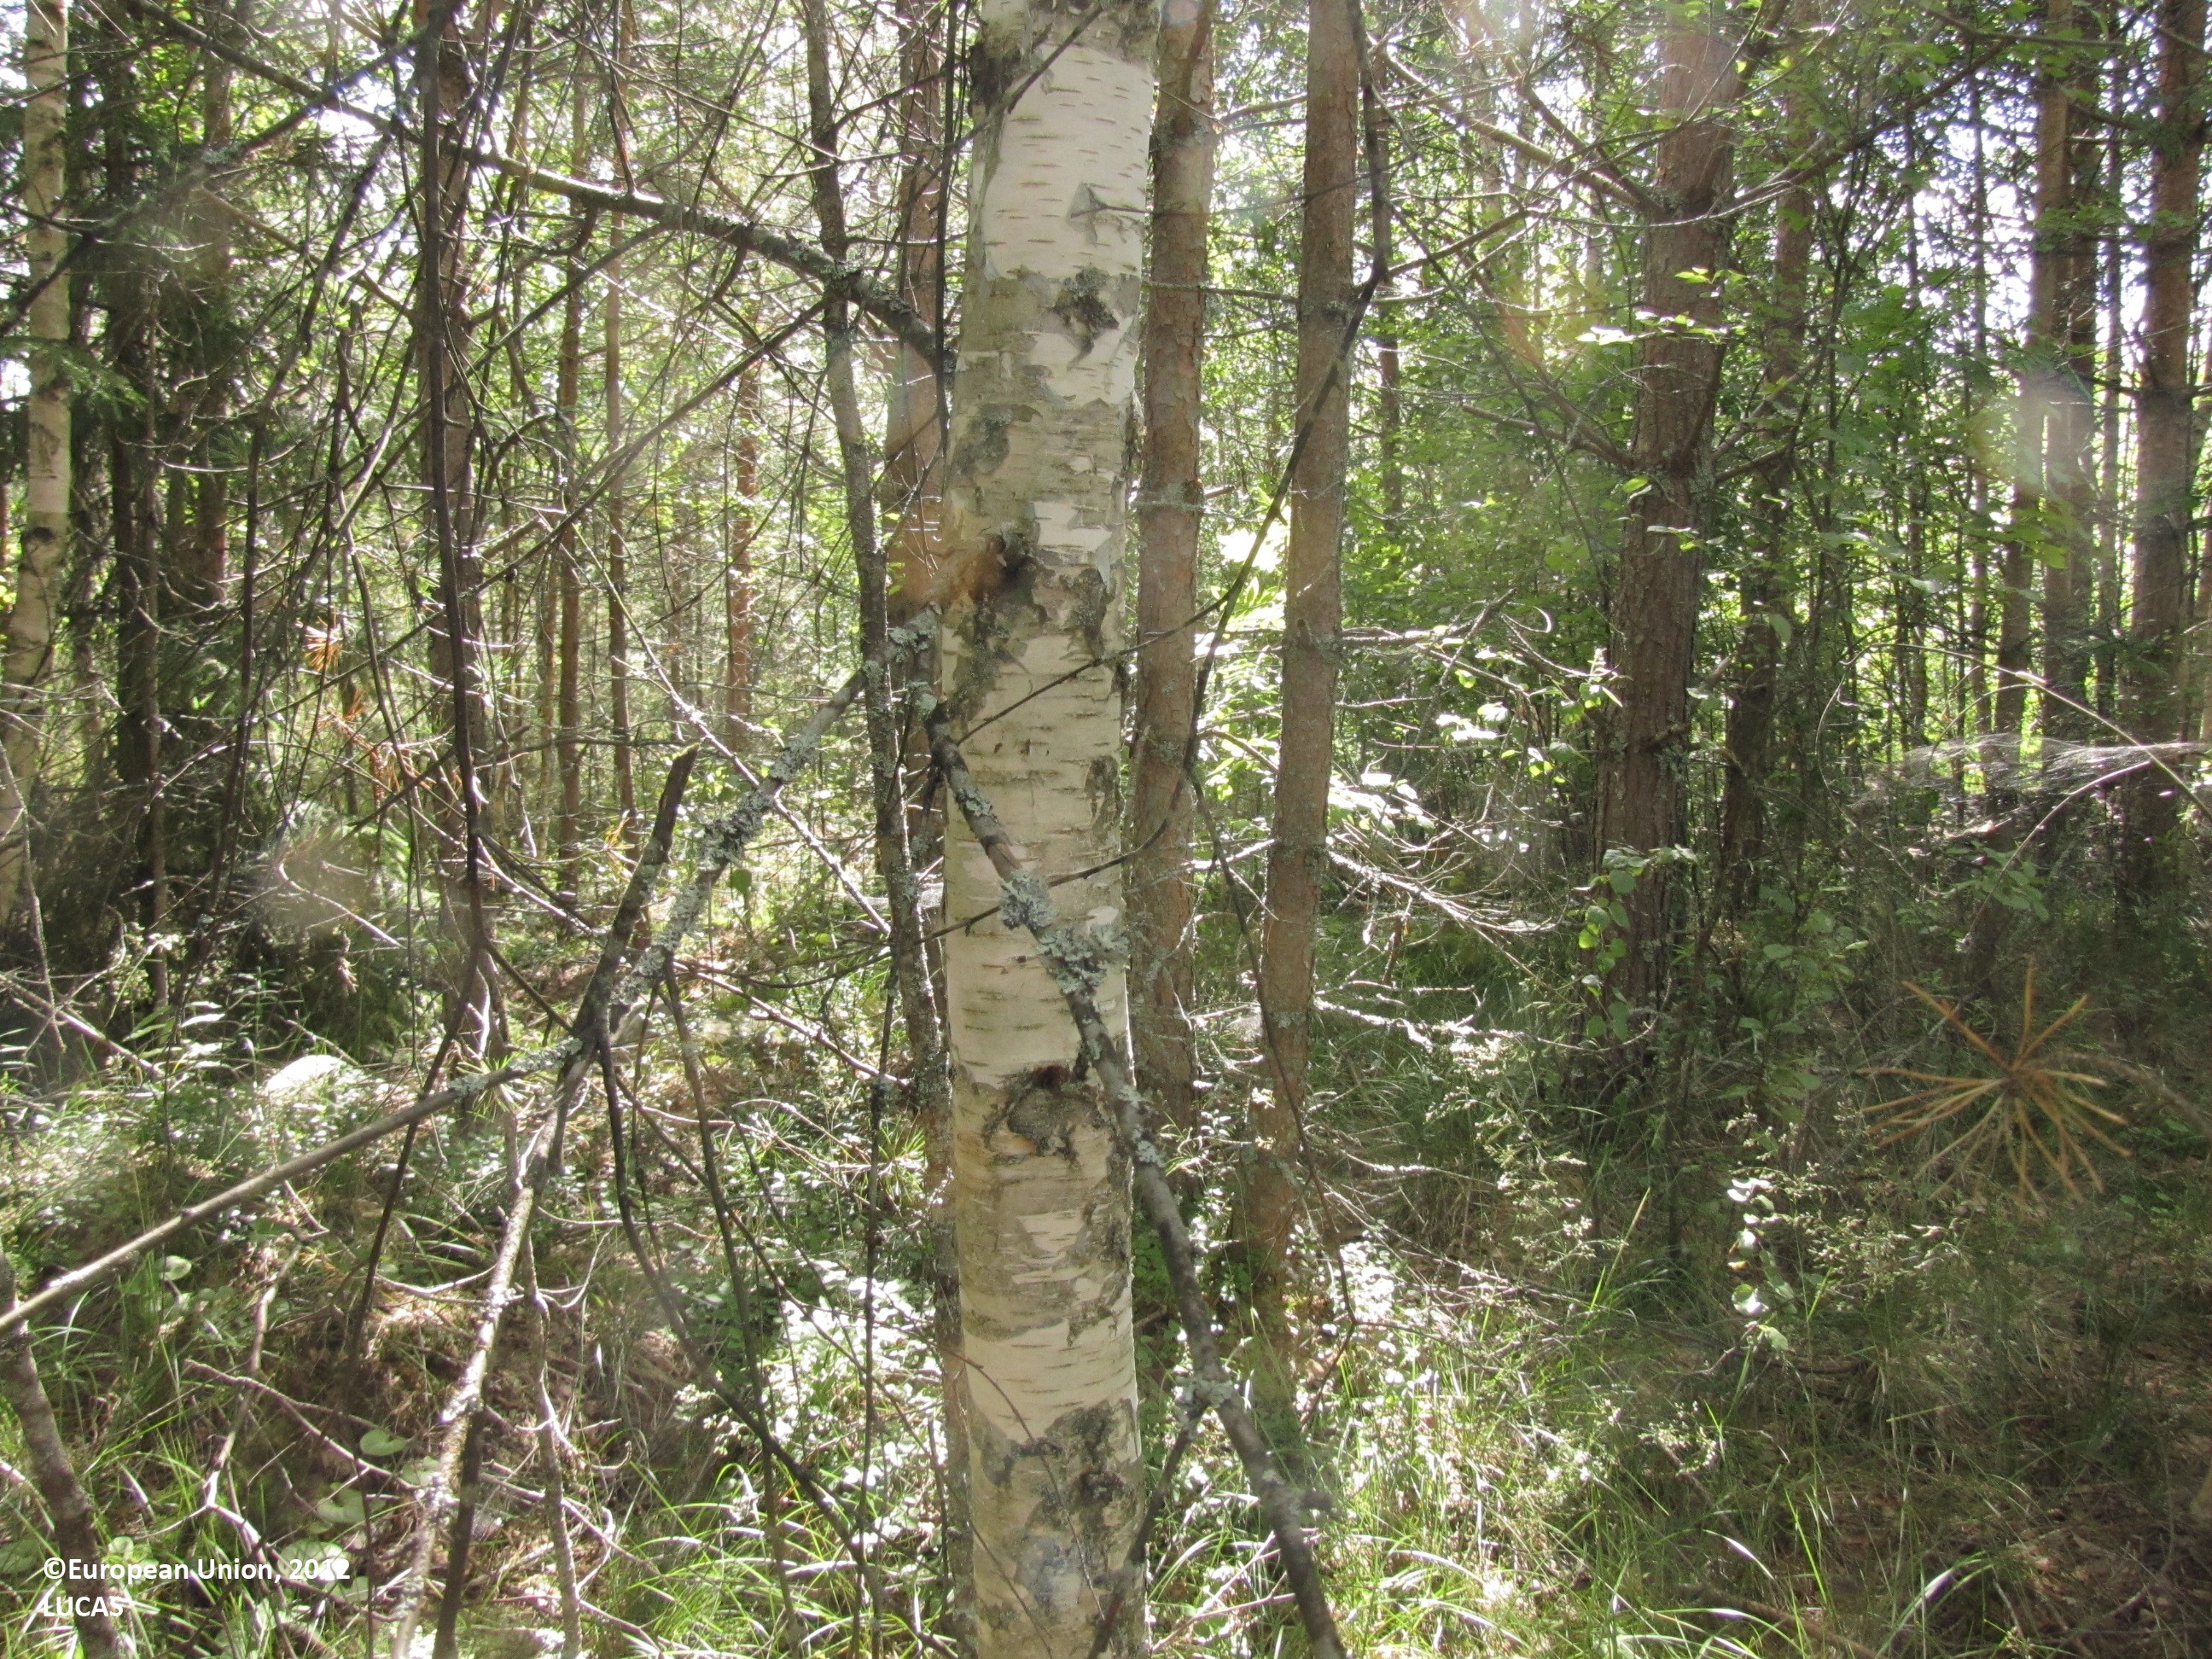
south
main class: Woodland
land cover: Pine dominated coniferous woodland
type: mire and swamp forests
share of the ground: > 75 %
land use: Forestry
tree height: > 5 m
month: July
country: FI
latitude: 62.5288
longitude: 23.3397
